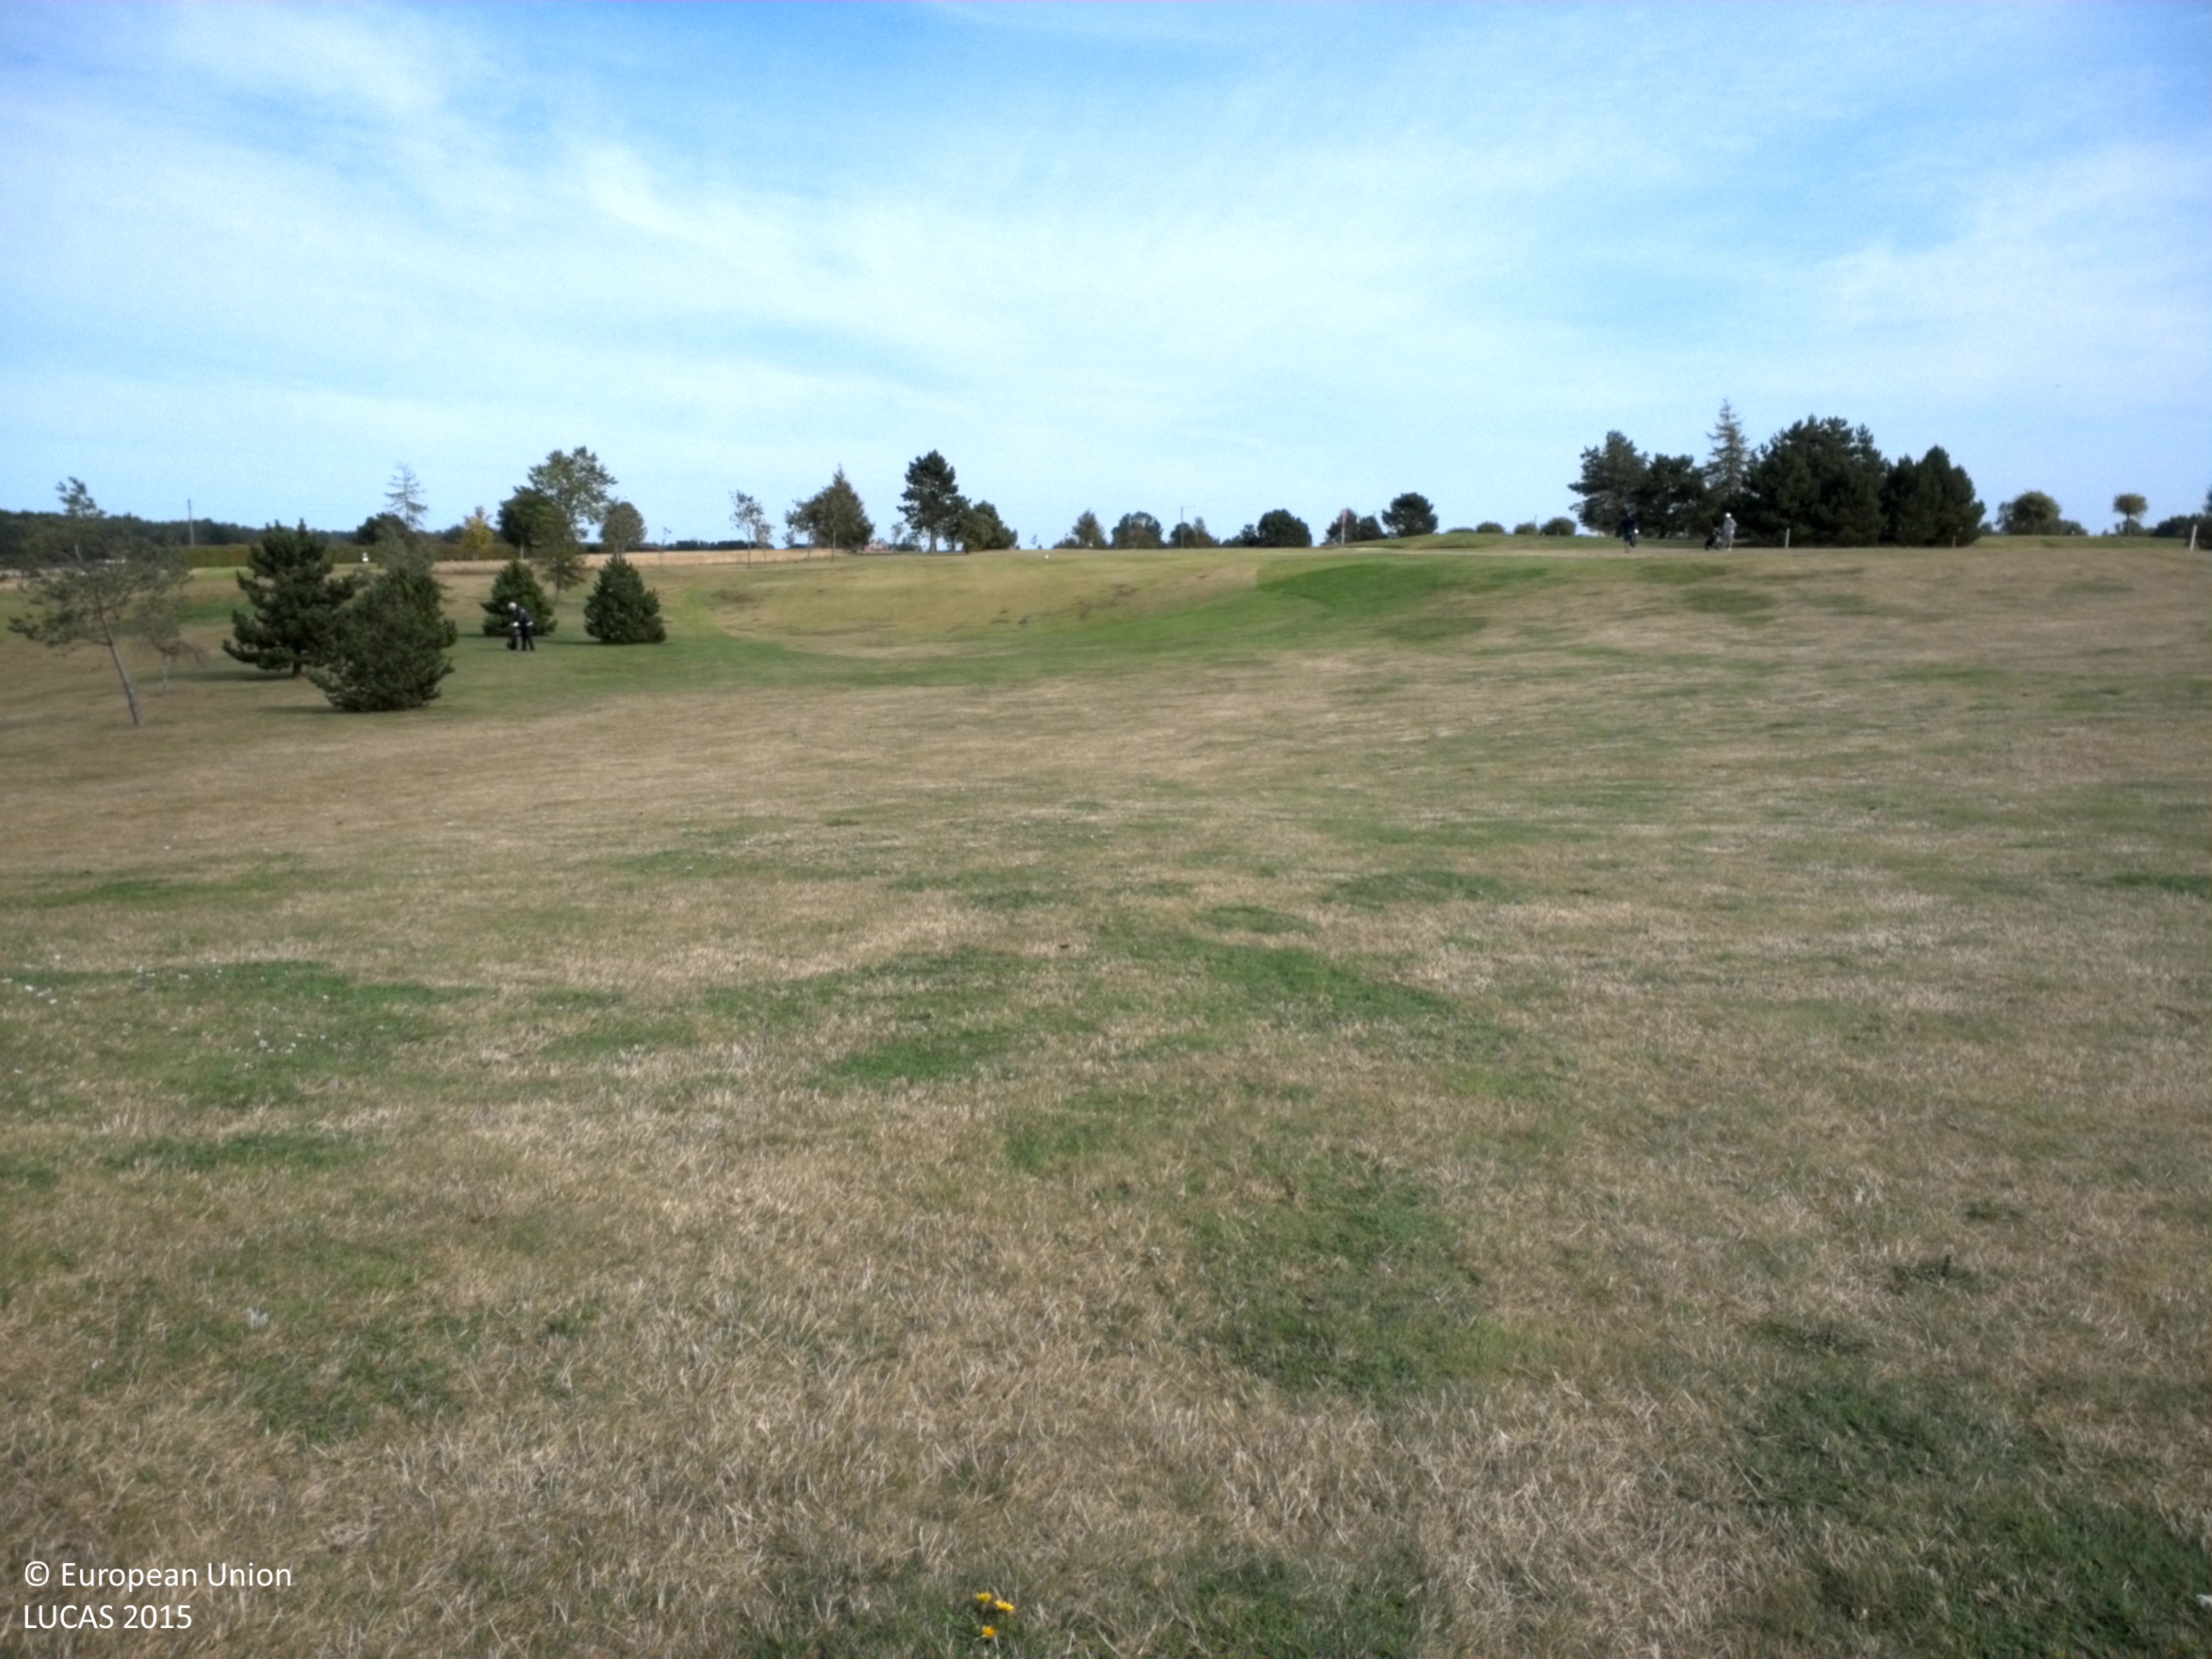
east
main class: Grassland
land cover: Grassland without tree/shrub cover
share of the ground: > 75 %
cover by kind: herbaceous plants 100 %
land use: Sport
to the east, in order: Grassland without tree/shrub cover; Sand; Grassland without tree/shrub cover; Sand; Grassland without tree/shrub cover; Sand; Grassland without tree/shrub cover
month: September
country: SE
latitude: 55.5323
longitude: 13.9752
